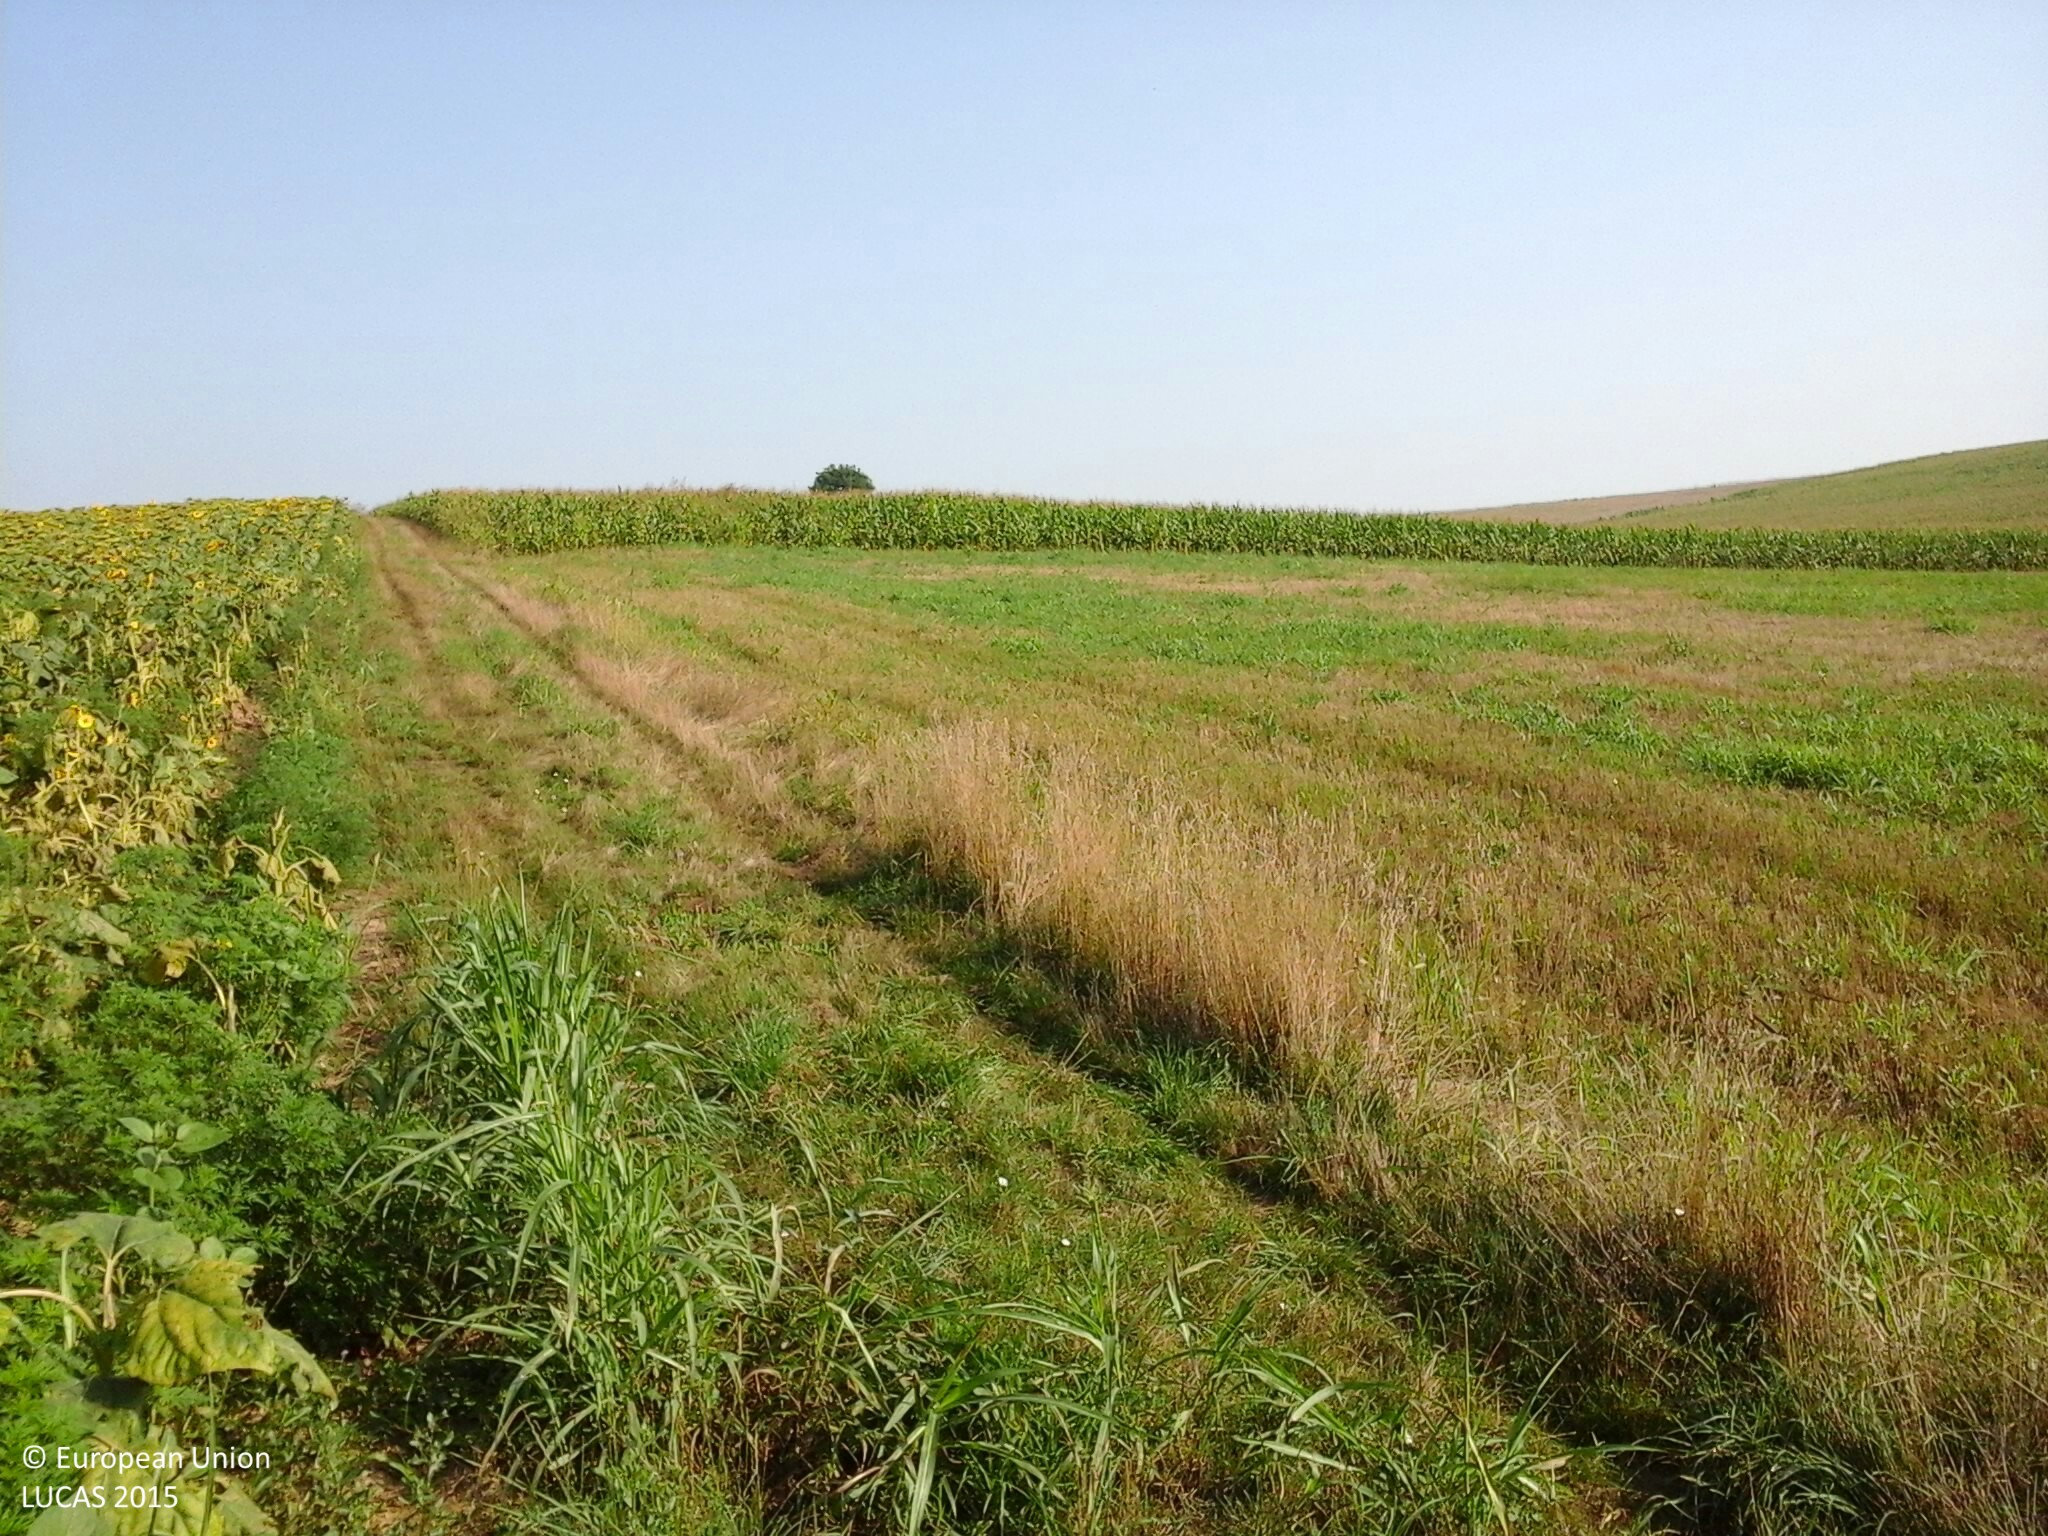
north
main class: Cropland
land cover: Sunflower
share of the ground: > 75 %
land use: Agriculture (excluding fallow land and kitchen gardens)
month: August
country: HU
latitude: 46.6074
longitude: 18.0637
